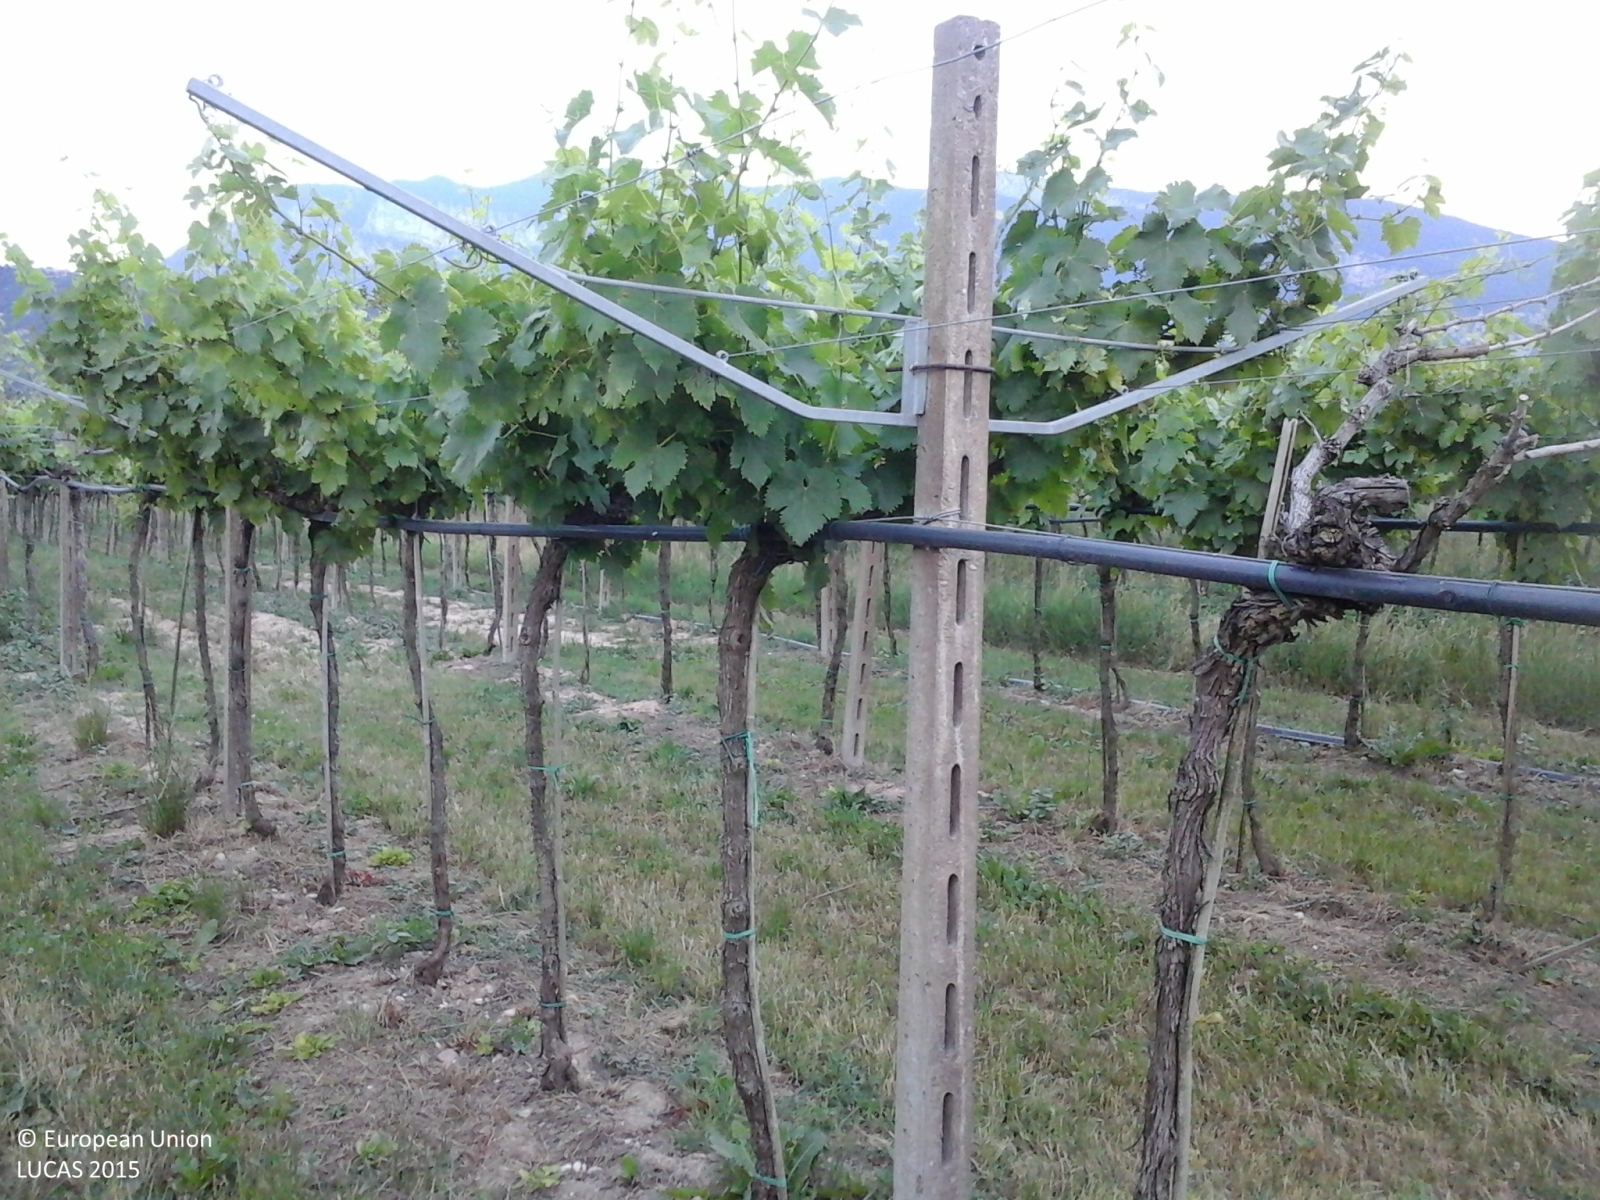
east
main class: Cropland
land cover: Vineyards
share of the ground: 50 - 75 %
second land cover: Grassland without tree/shrub cover
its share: > 75 %
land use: Agriculture (excluding fallow land and kitchen gardens)
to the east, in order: Vineyards; Grassland without tree/shrub cover; Vineyards; Grassland without tree/shrub cover; Tracks; Vineyards
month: June
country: IT
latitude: 45.5914
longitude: 10.8062
